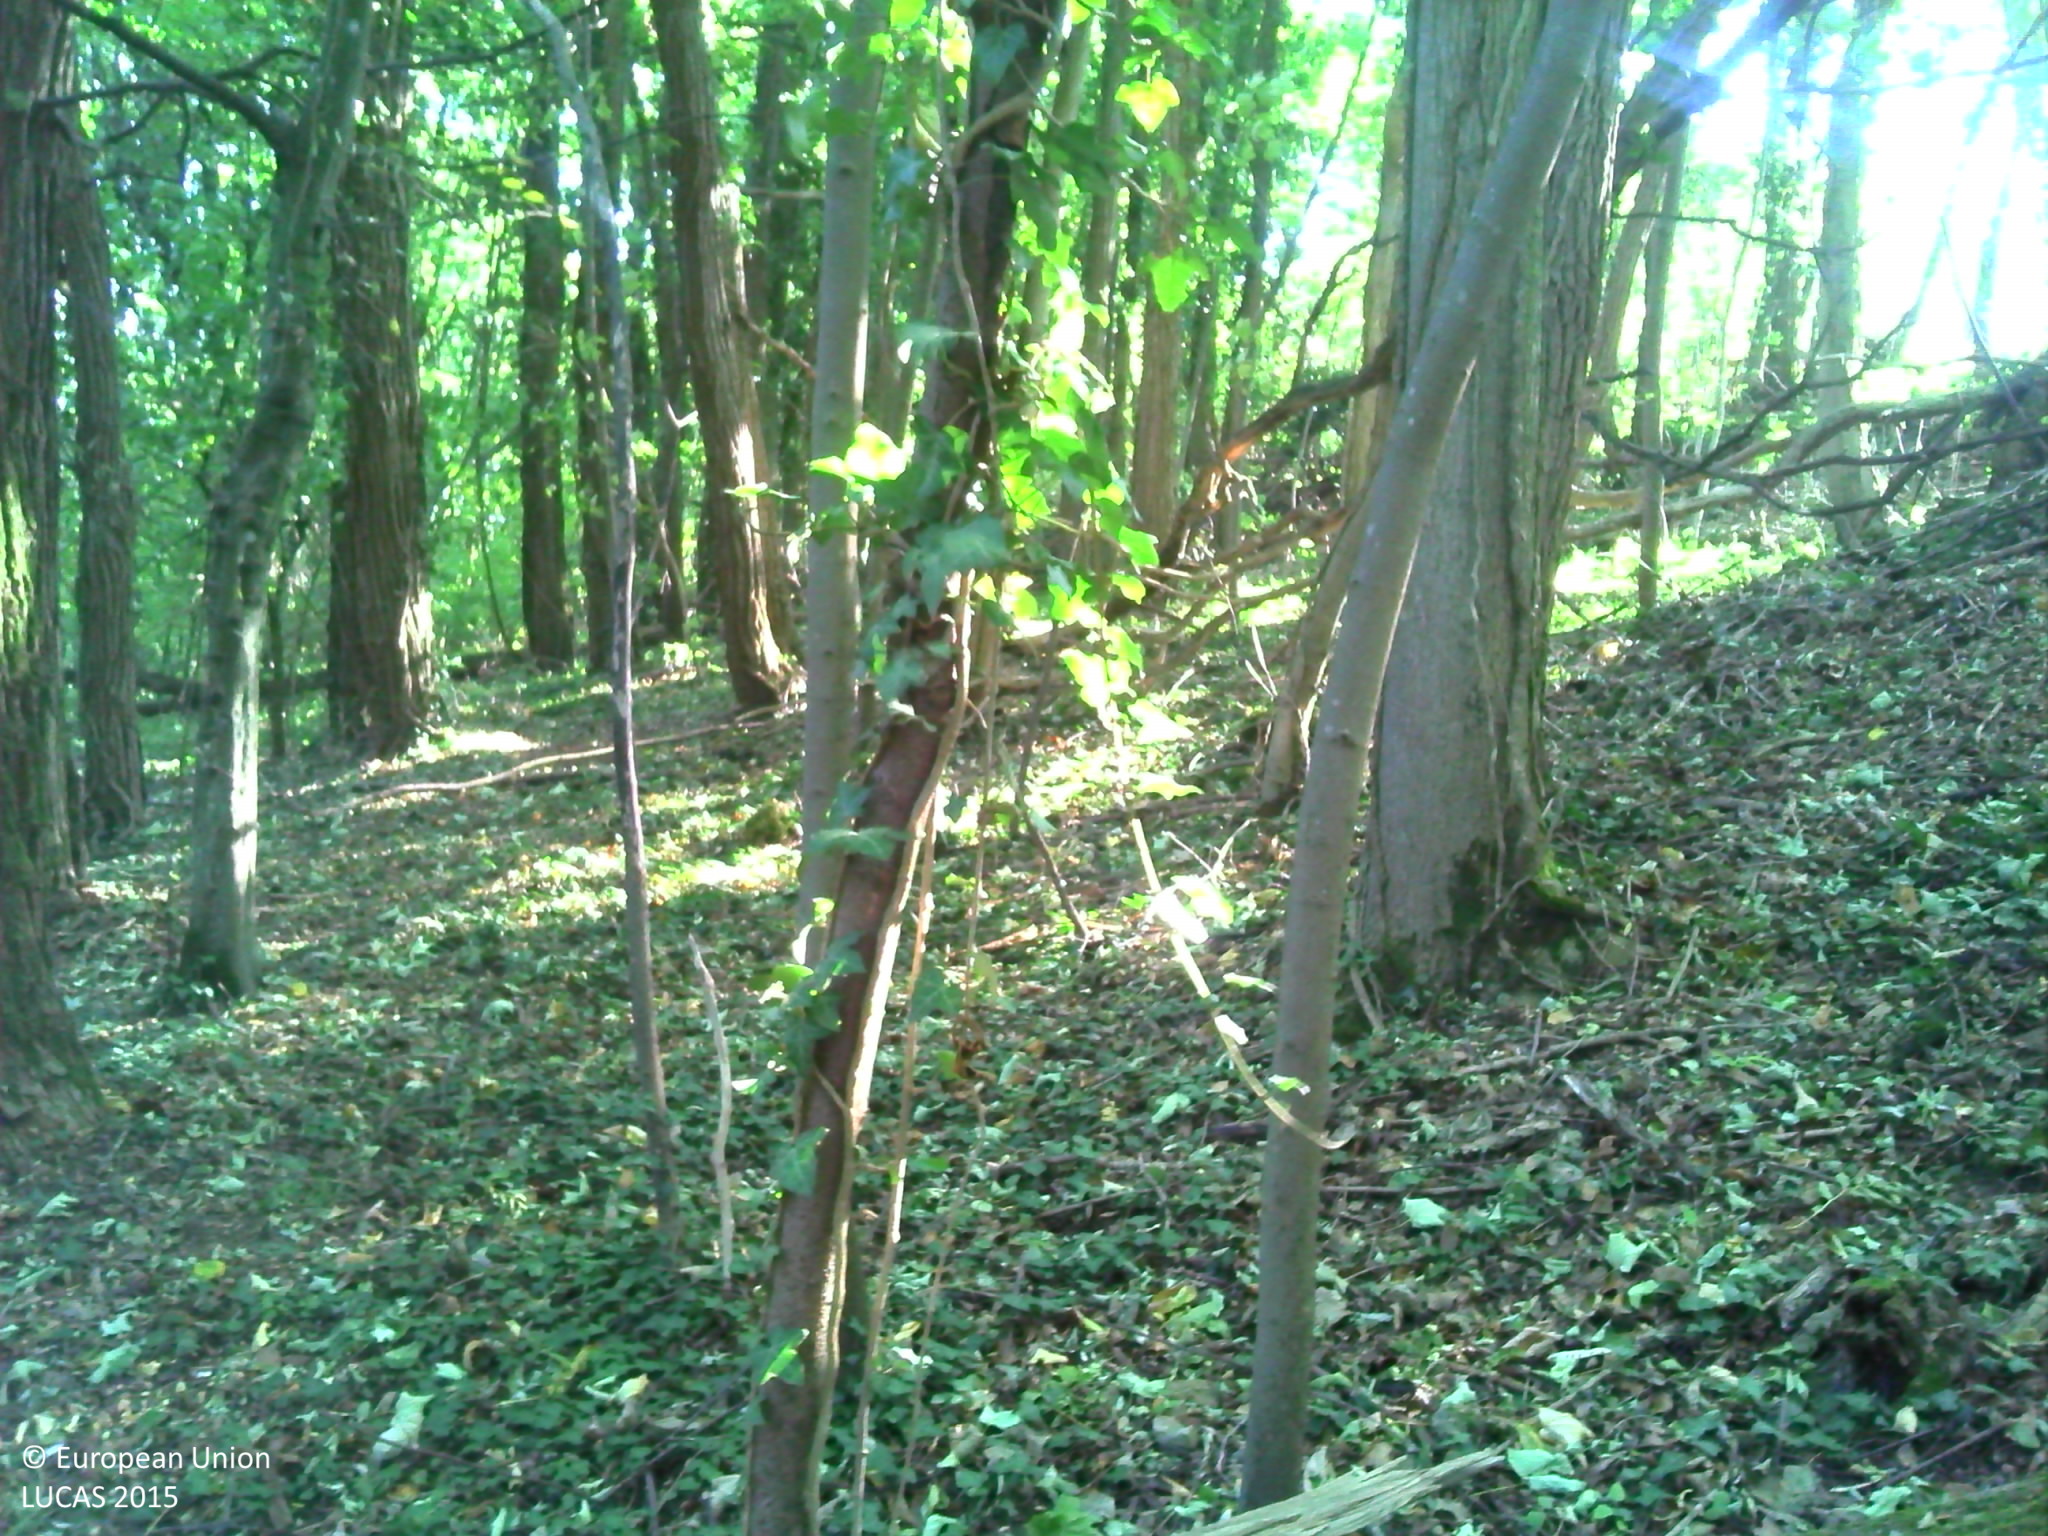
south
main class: Woodland
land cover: Broadleaved woodland
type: mesophytic deciduous forest
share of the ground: > 75 %
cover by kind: broadleaved forest trees 90 %, herbaceous plants 5 %, consolidated bare surface 5 %
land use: Forestry
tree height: > 5 m
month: October
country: FR
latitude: 48.9086
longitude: 6.0293
